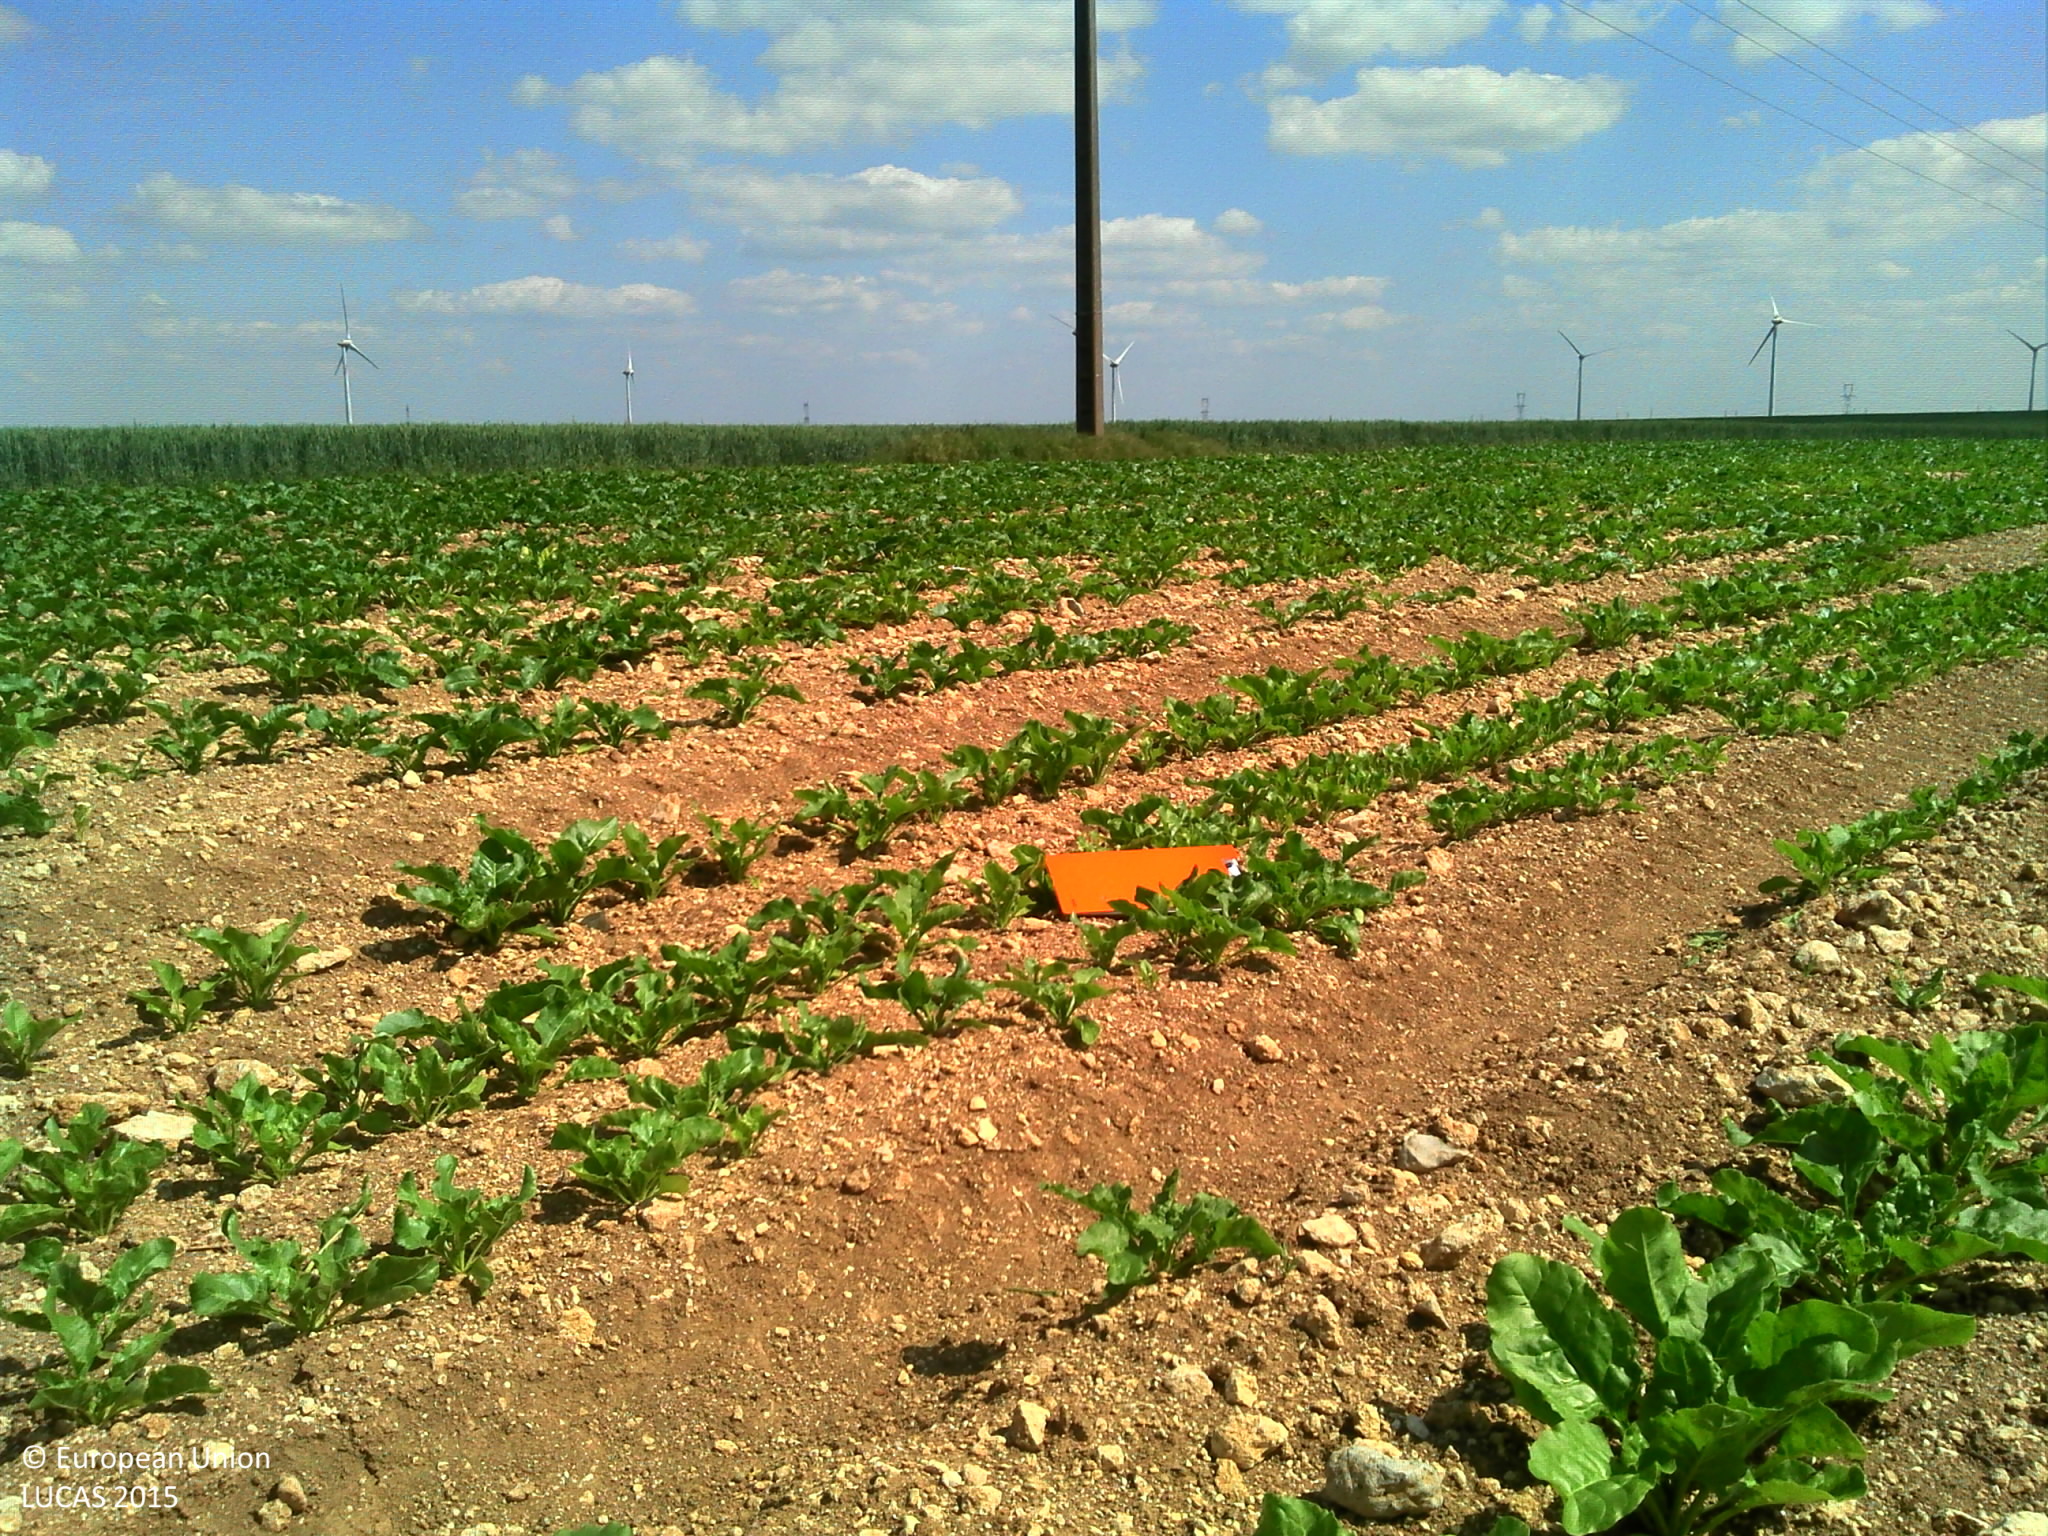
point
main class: Cropland
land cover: Sugar beet
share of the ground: 10 - 25 %
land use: Agriculture (excluding fallow land and kitchen gardens)
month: May
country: FR
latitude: 48.2699
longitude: 1.9162
